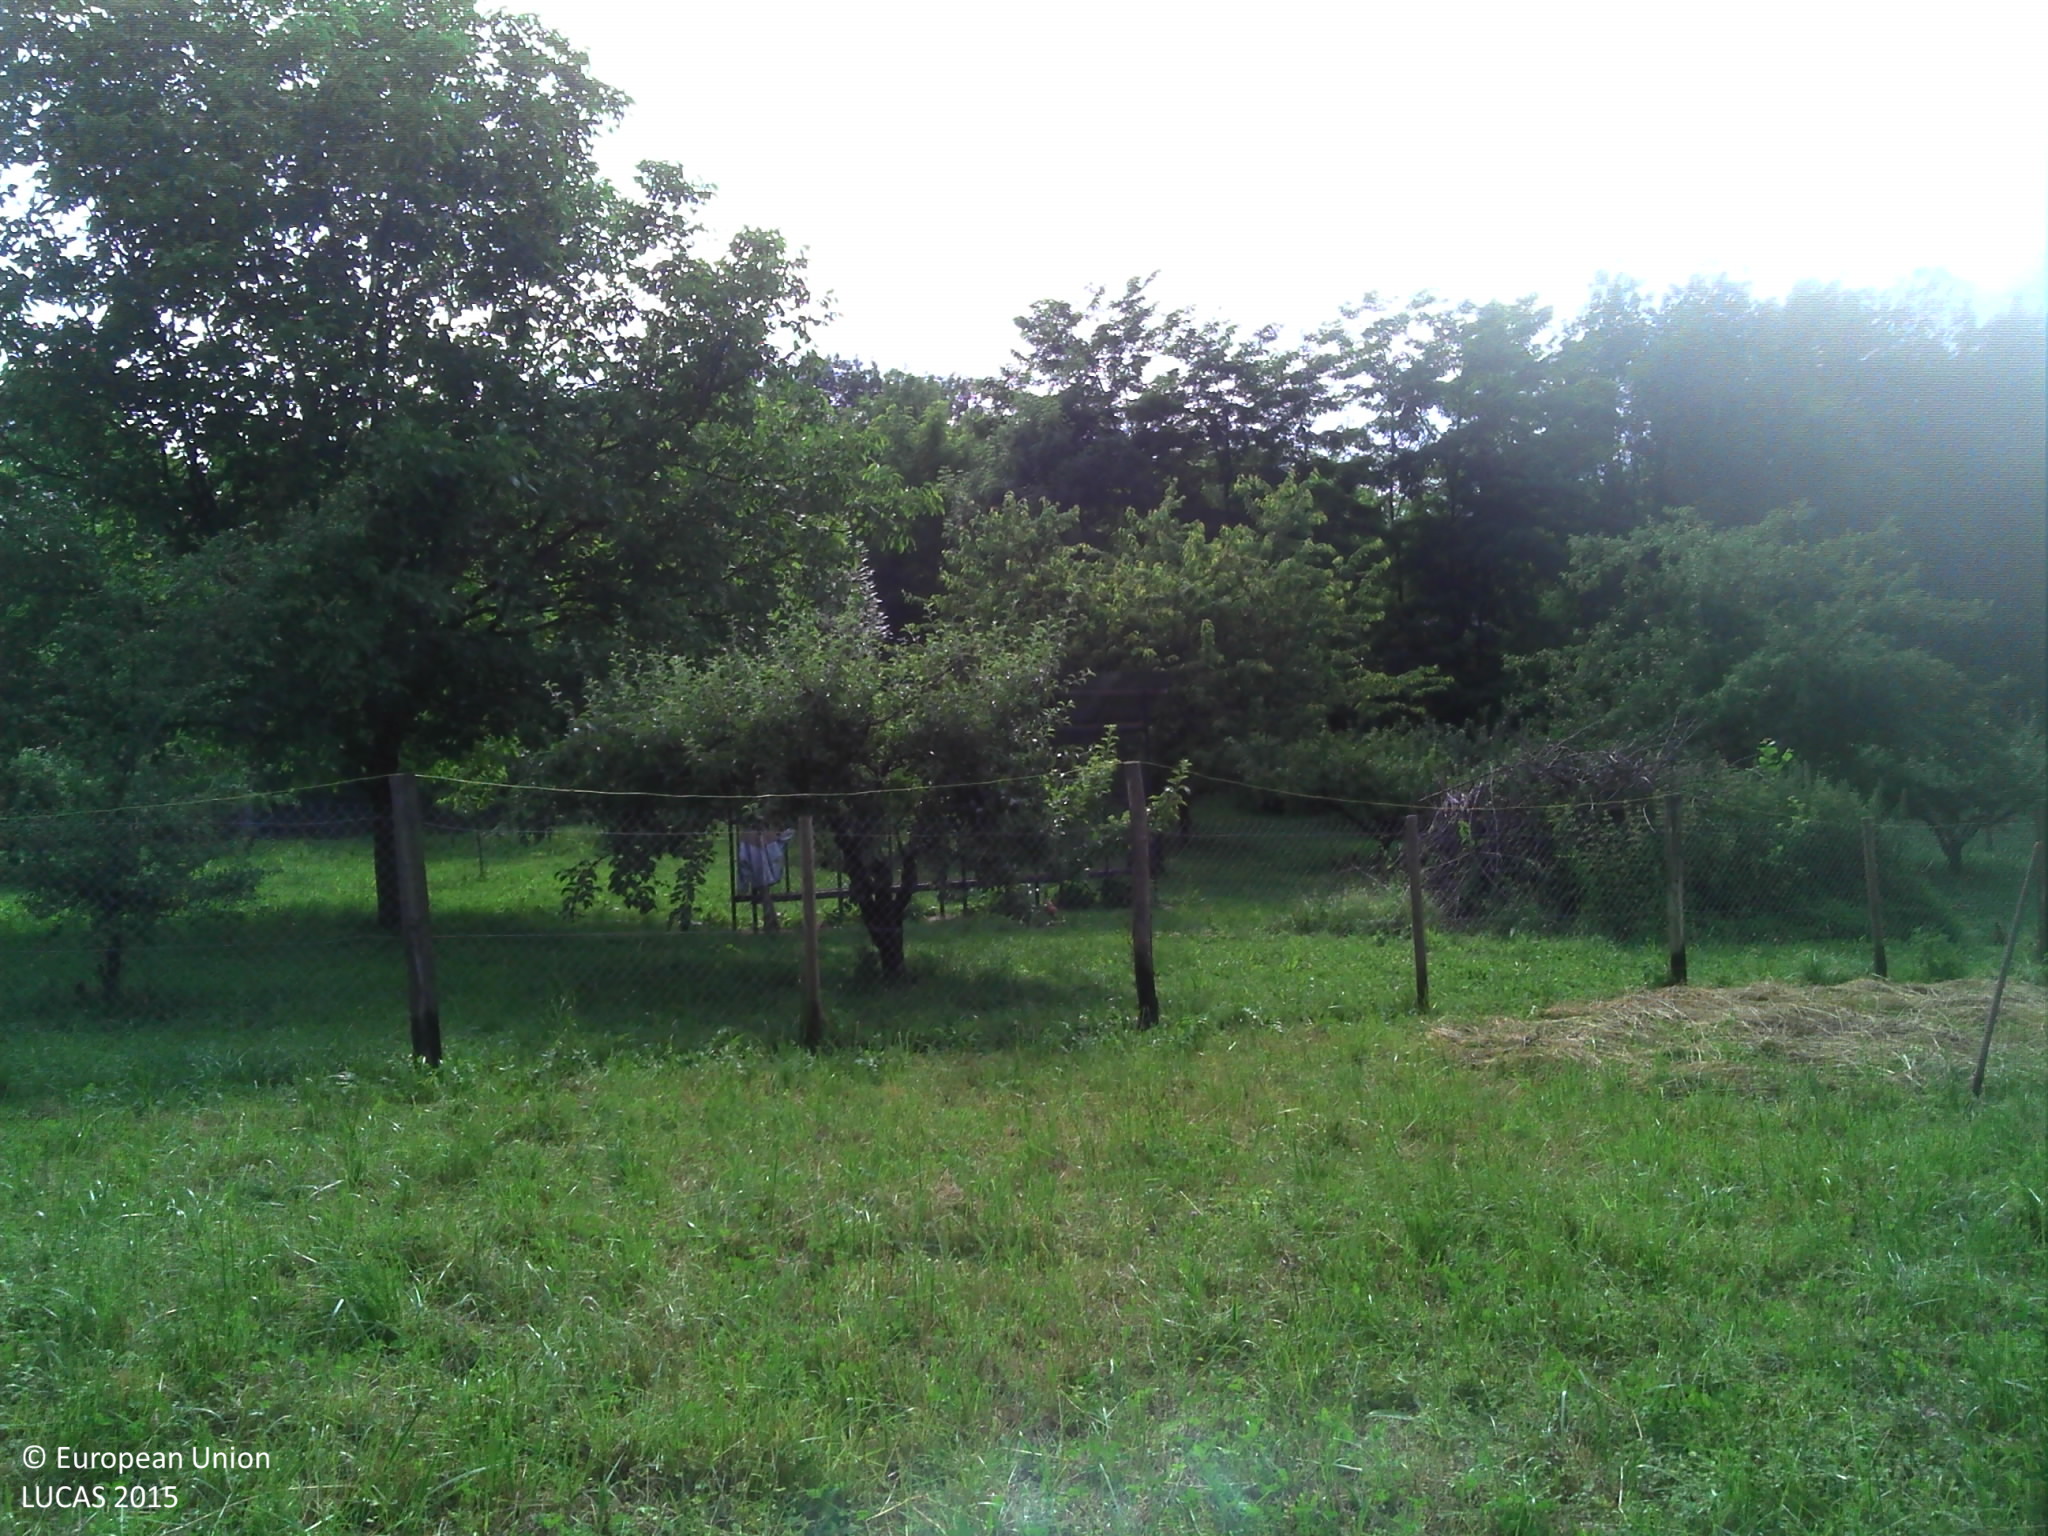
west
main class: Cropland
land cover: Nuts trees
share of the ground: < 10 %
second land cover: Grassland without tree/shrub cover
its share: > 75 %
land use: Agriculture (excluding fallow land and kitchen gardens)
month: June
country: FR
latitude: 45.5263
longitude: 6.2020
